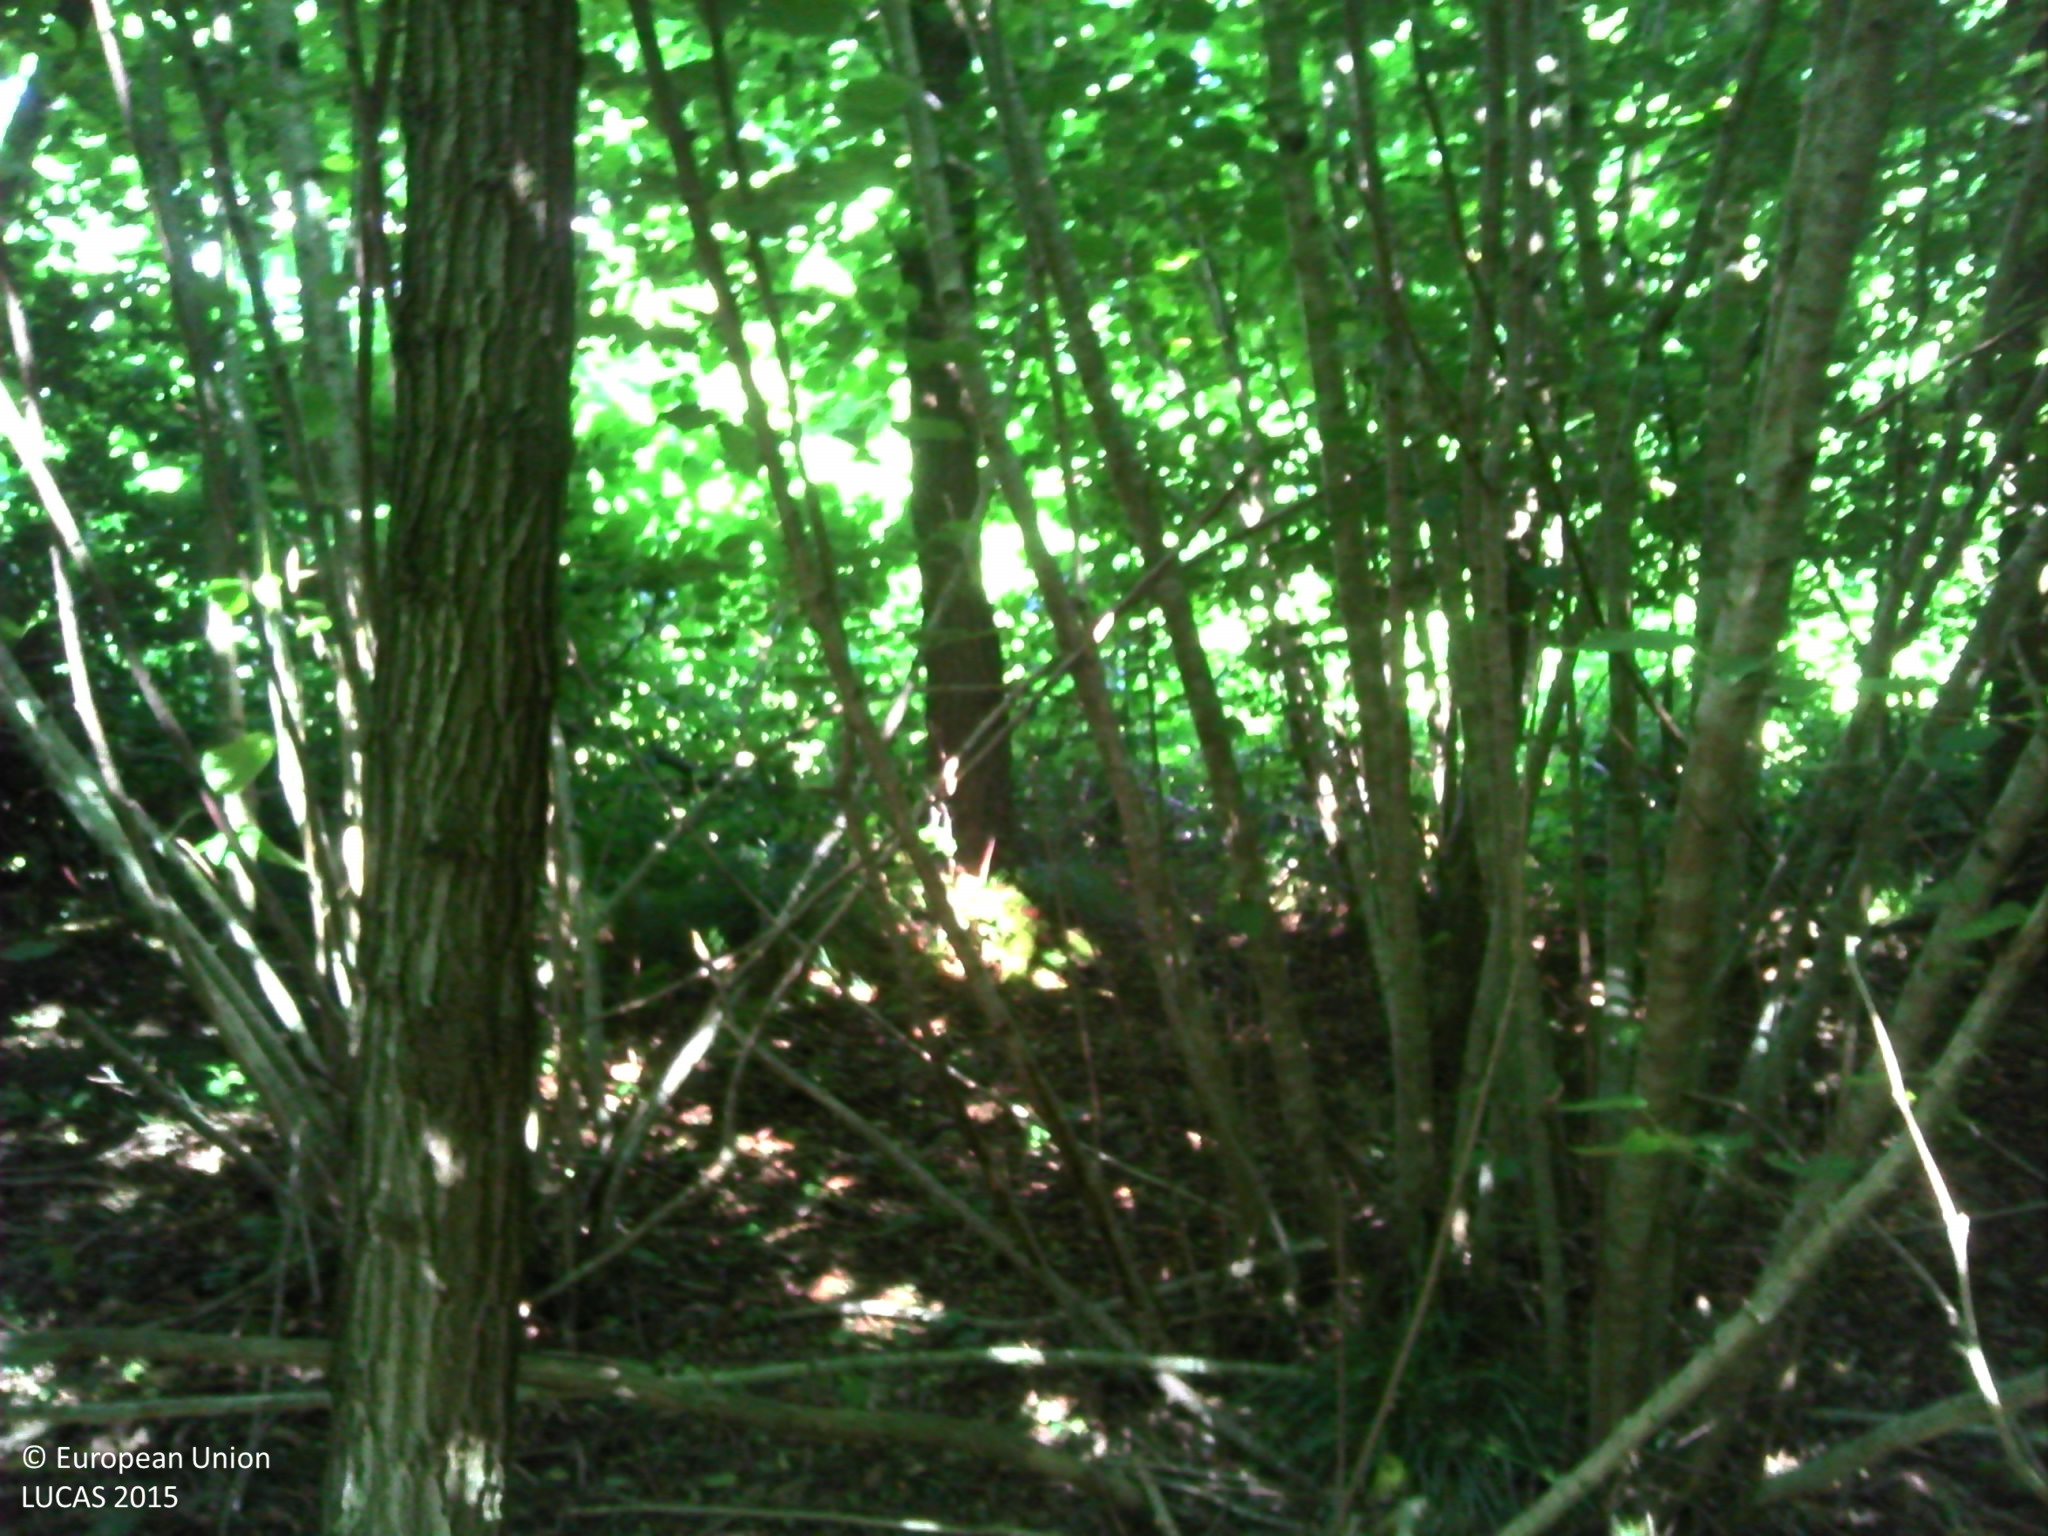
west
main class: Woodland
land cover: Broadleaved woodland
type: mesophytic deciduous forest
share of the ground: > 75 %
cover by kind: broadleaved forest trees 90 %, herbaceous plants 5 %, lichens and mosses 5 %
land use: Forestry
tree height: > 5 m
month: July
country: FR
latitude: 48.4320
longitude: 6.3106
